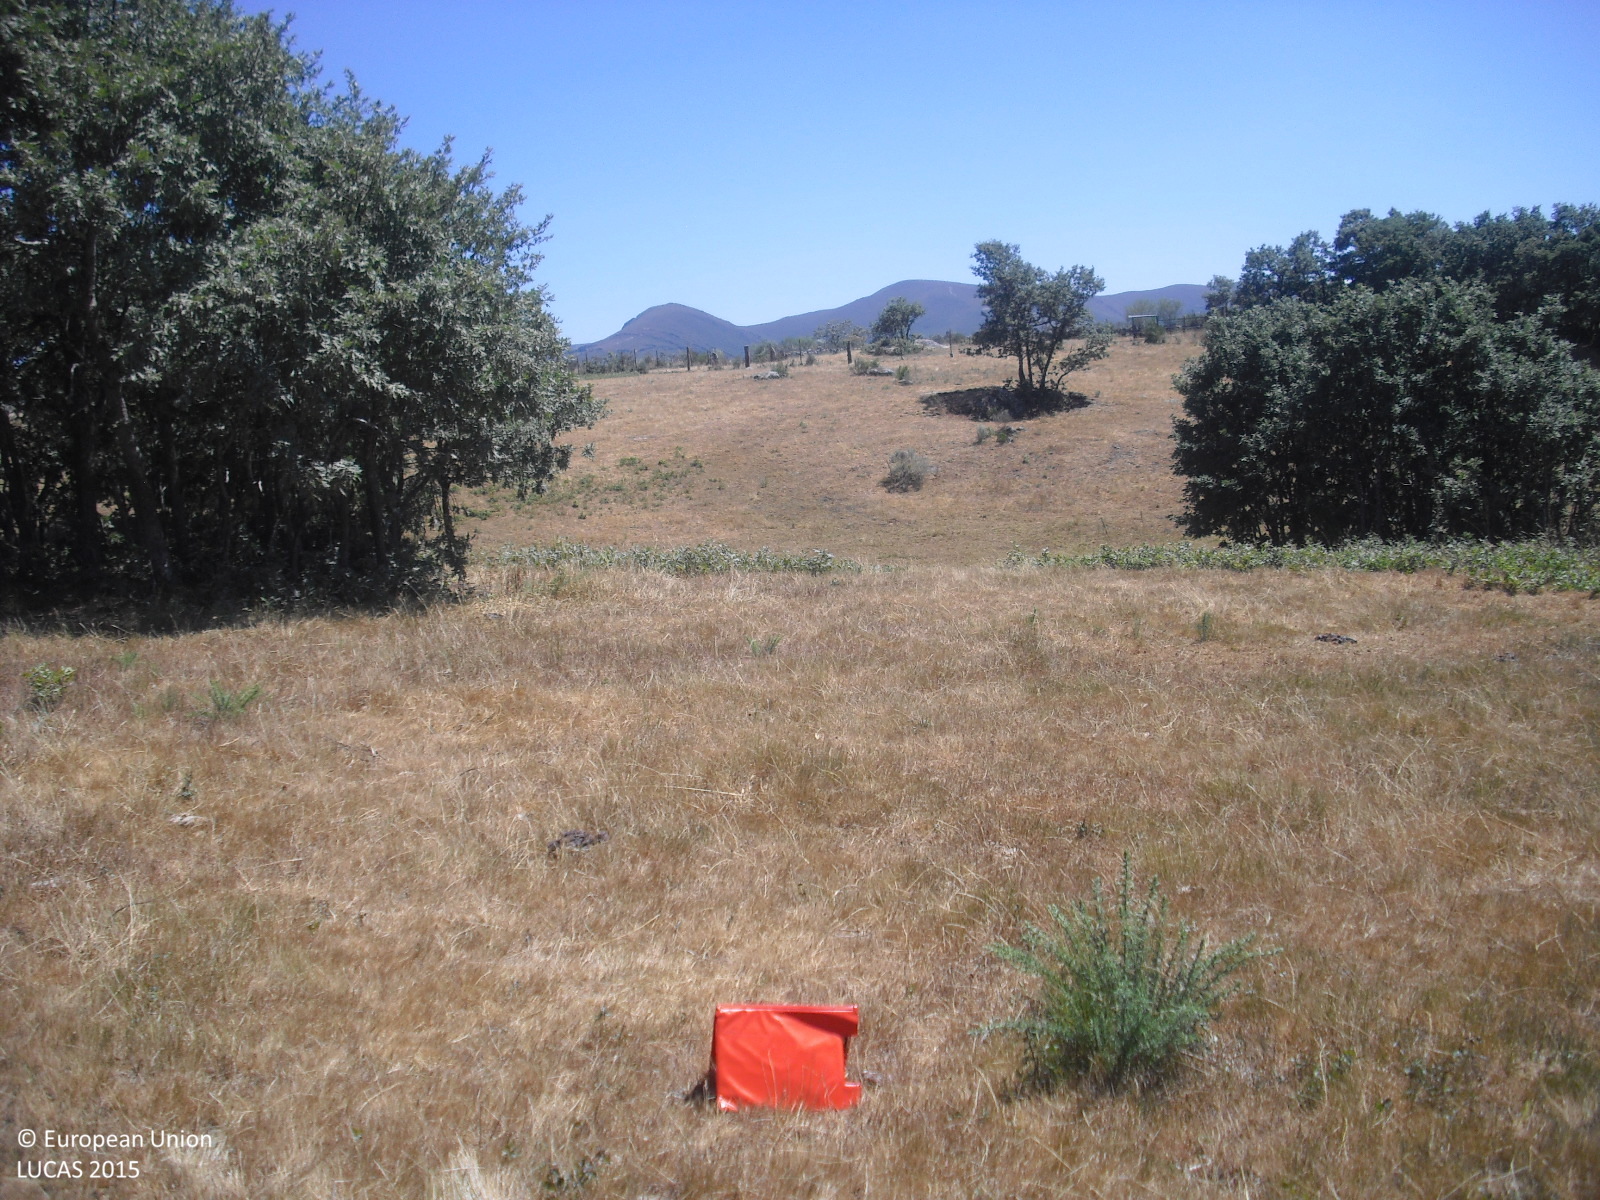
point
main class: Grassland
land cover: Grassland with sparse tree/shrub cover
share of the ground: > 75 %
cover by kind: herbaceous plants 90 %, broadleaved forest trees 5 %, shrubs 5 %
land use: Agriculture (excluding fallow land and kitchen gardens)
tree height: > 5 m
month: July
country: ES
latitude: 42.2703
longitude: -7.4385
